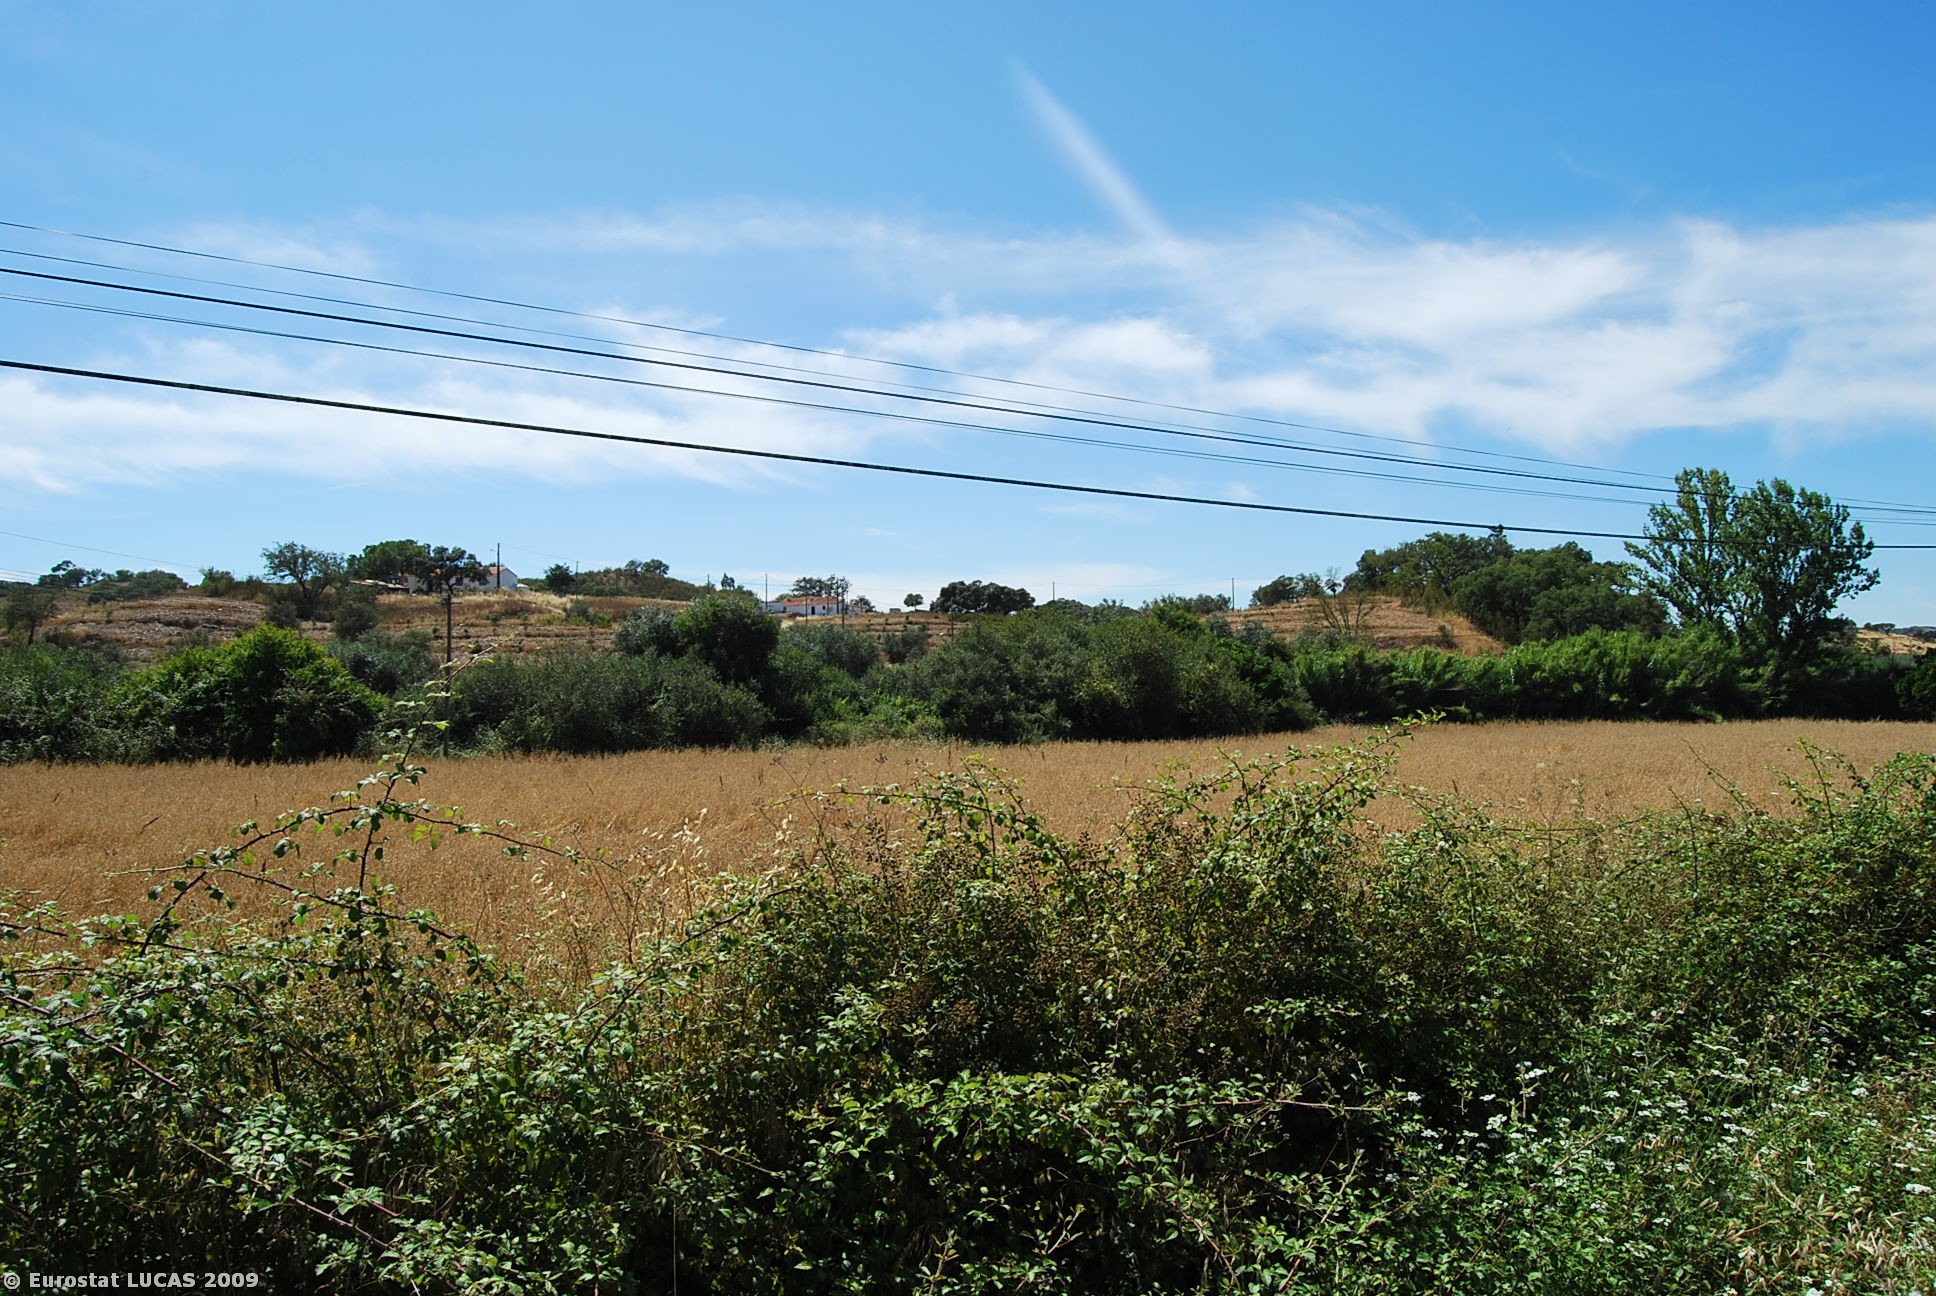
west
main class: Grassland
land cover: Spontaneously vegetated surfaces
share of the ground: > 75 %
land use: Fallow land
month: July
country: PT
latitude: 37.6745
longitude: -8.4129
